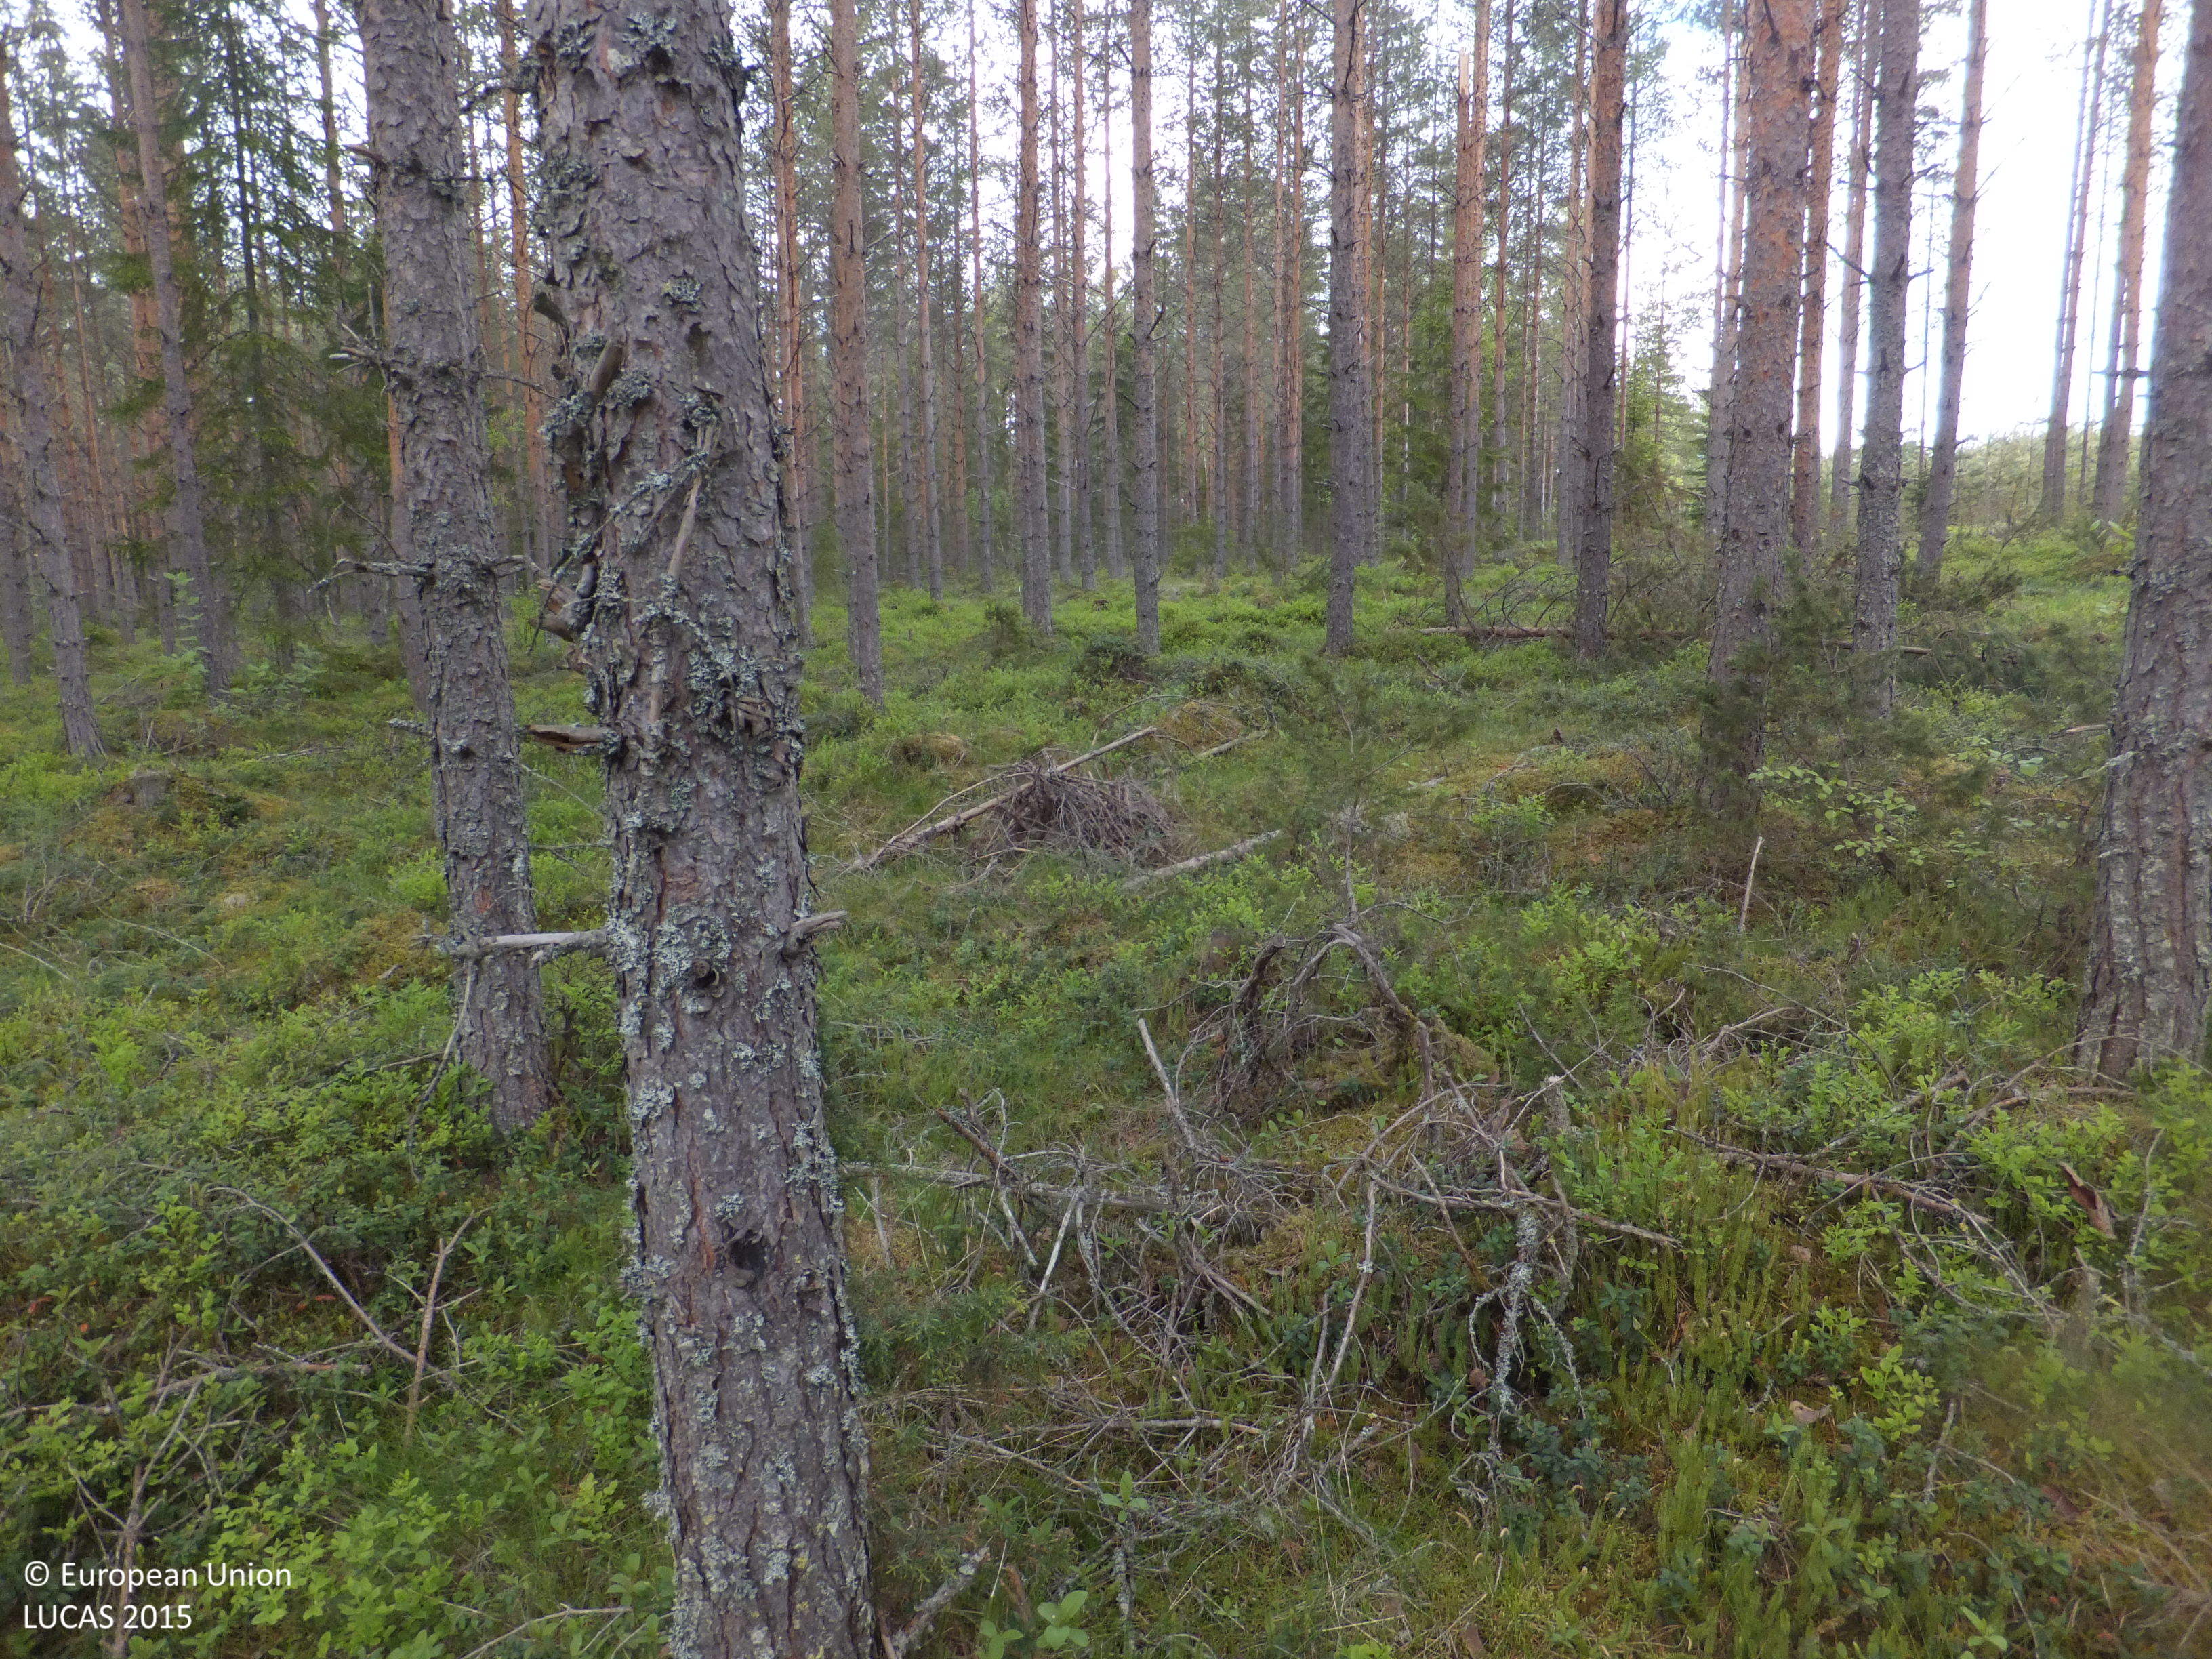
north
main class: Woodland
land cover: Pine dominated coniferous woodland
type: boreal forest
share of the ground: > 75 %
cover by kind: coniferous forest trees 90 %, shrubs 5 %, herbaceous plants 5 %
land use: Forestry
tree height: > 5 m
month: June
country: FI
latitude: 63.4941
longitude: 23.2122
